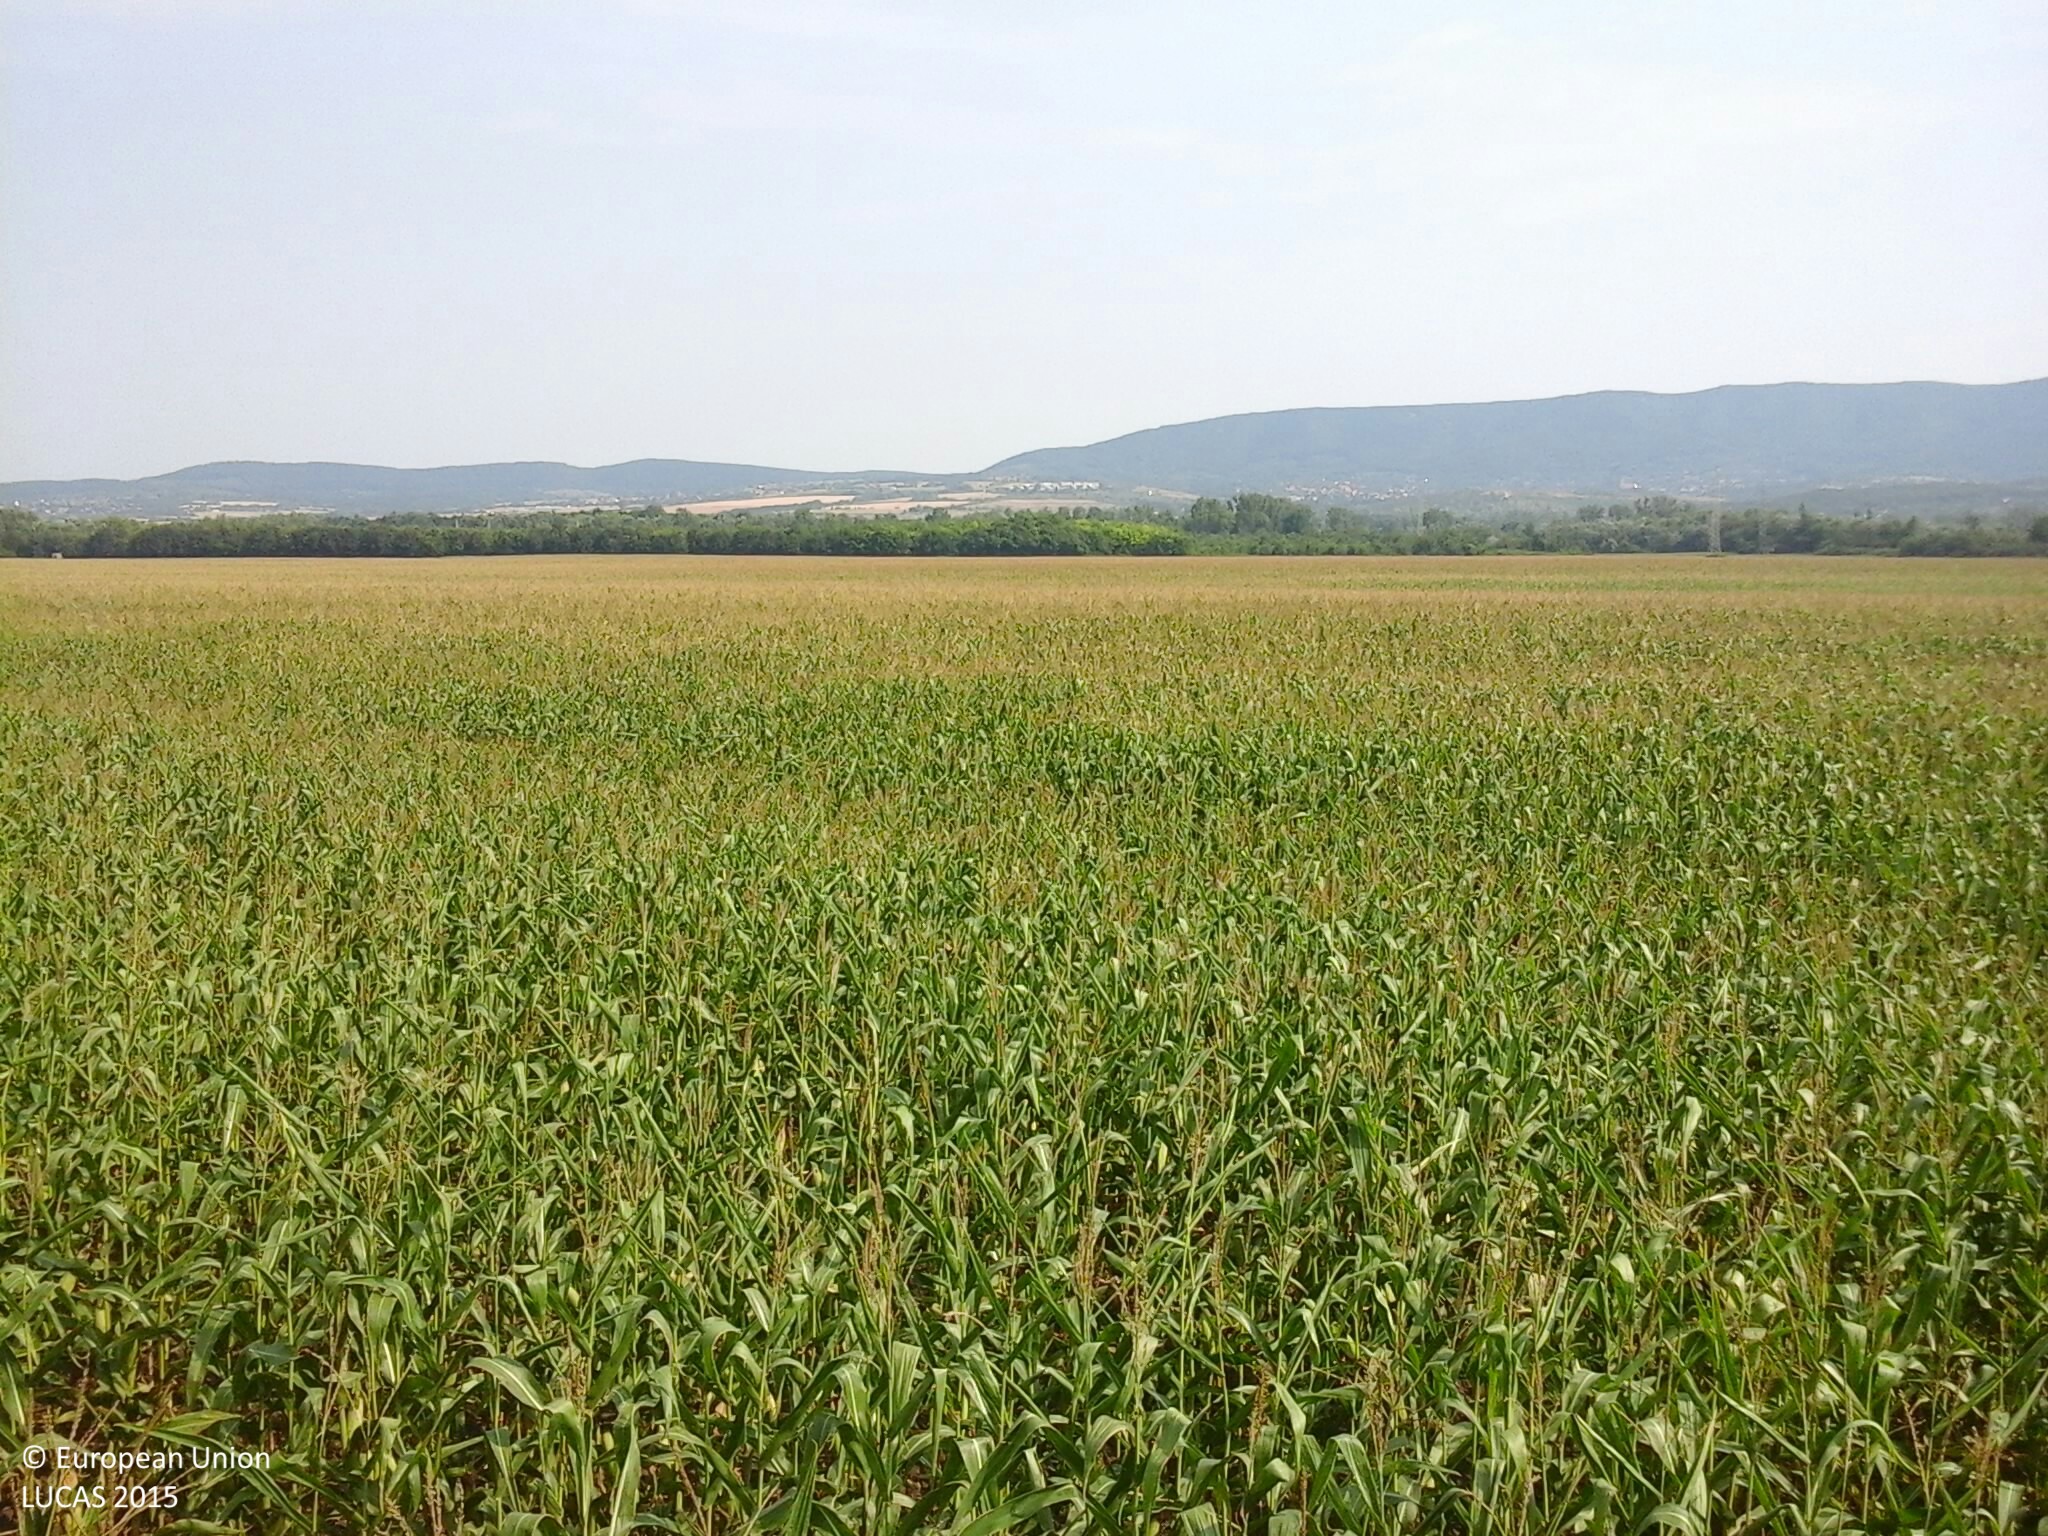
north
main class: Artificial land
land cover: Other artificial areas
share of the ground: < 10 %
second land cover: Maize
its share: > 75 %
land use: Electricity, gas and thermal power distribution
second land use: Agriculture (excluding fallow land and kitchen gardens)
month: August
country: HU
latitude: 46.0430
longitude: 18.1087
